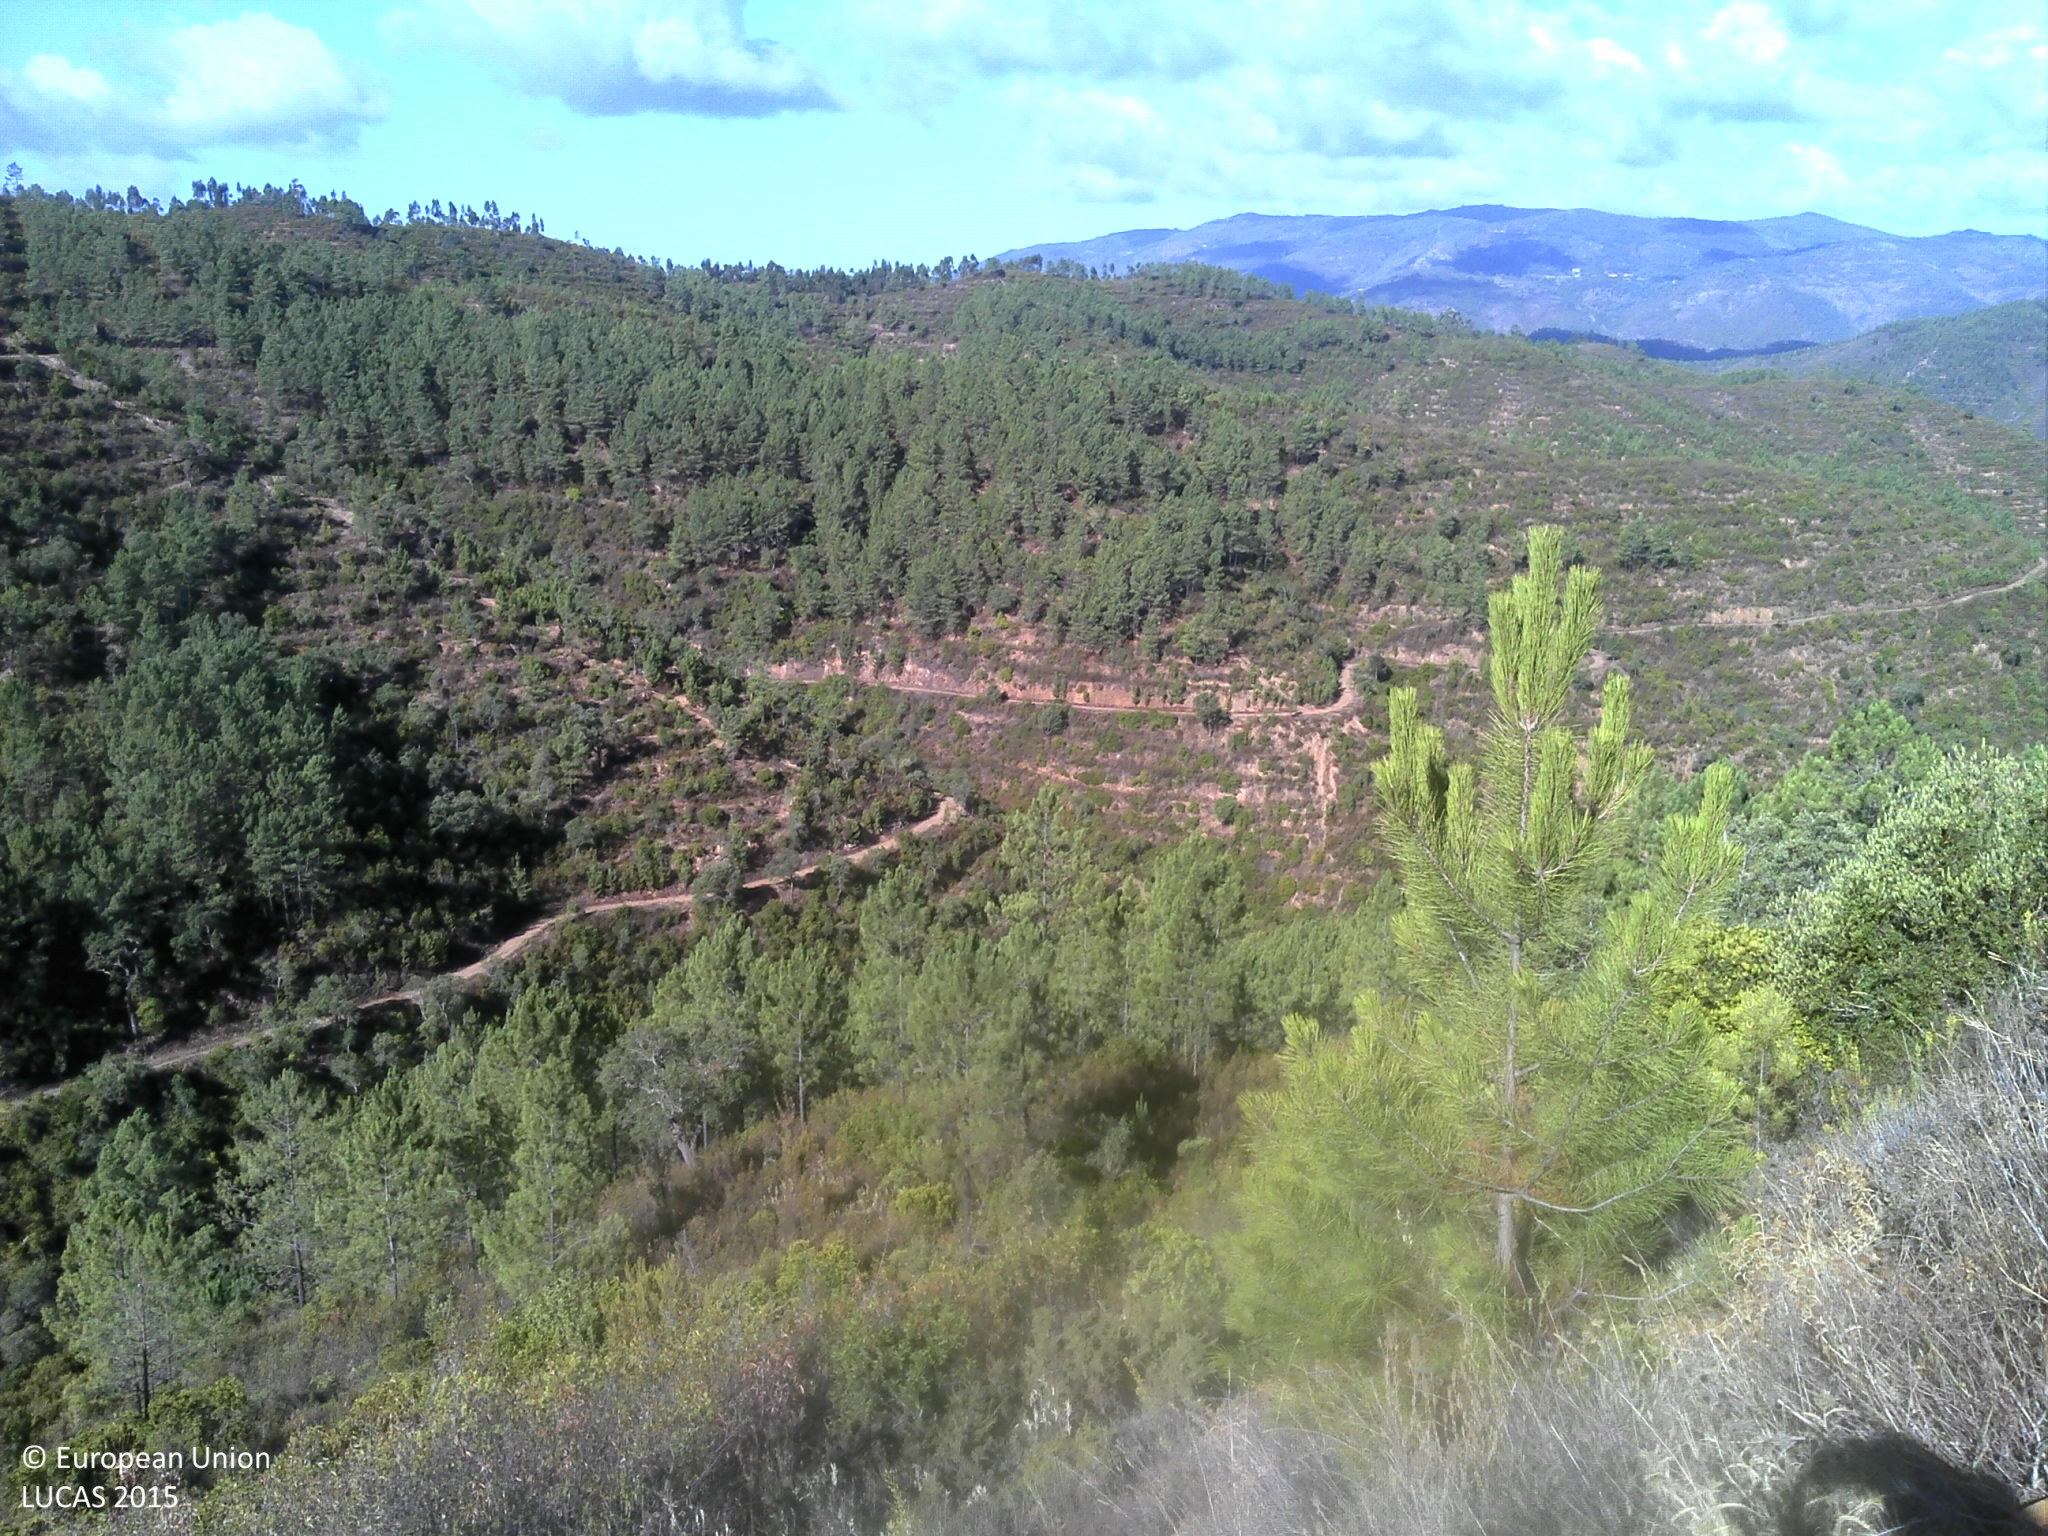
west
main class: Woodland
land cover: Pine dominated coniferous woodland
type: coniferous forest of the mediterranean region
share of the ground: 25 - 50 %
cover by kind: shrubs 55 %, coniferous forest trees 25 %, unconsolidated bare surface 20 %
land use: Forestry
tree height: > 5 m
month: September
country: PT
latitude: 37.3014
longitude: -8.4268
